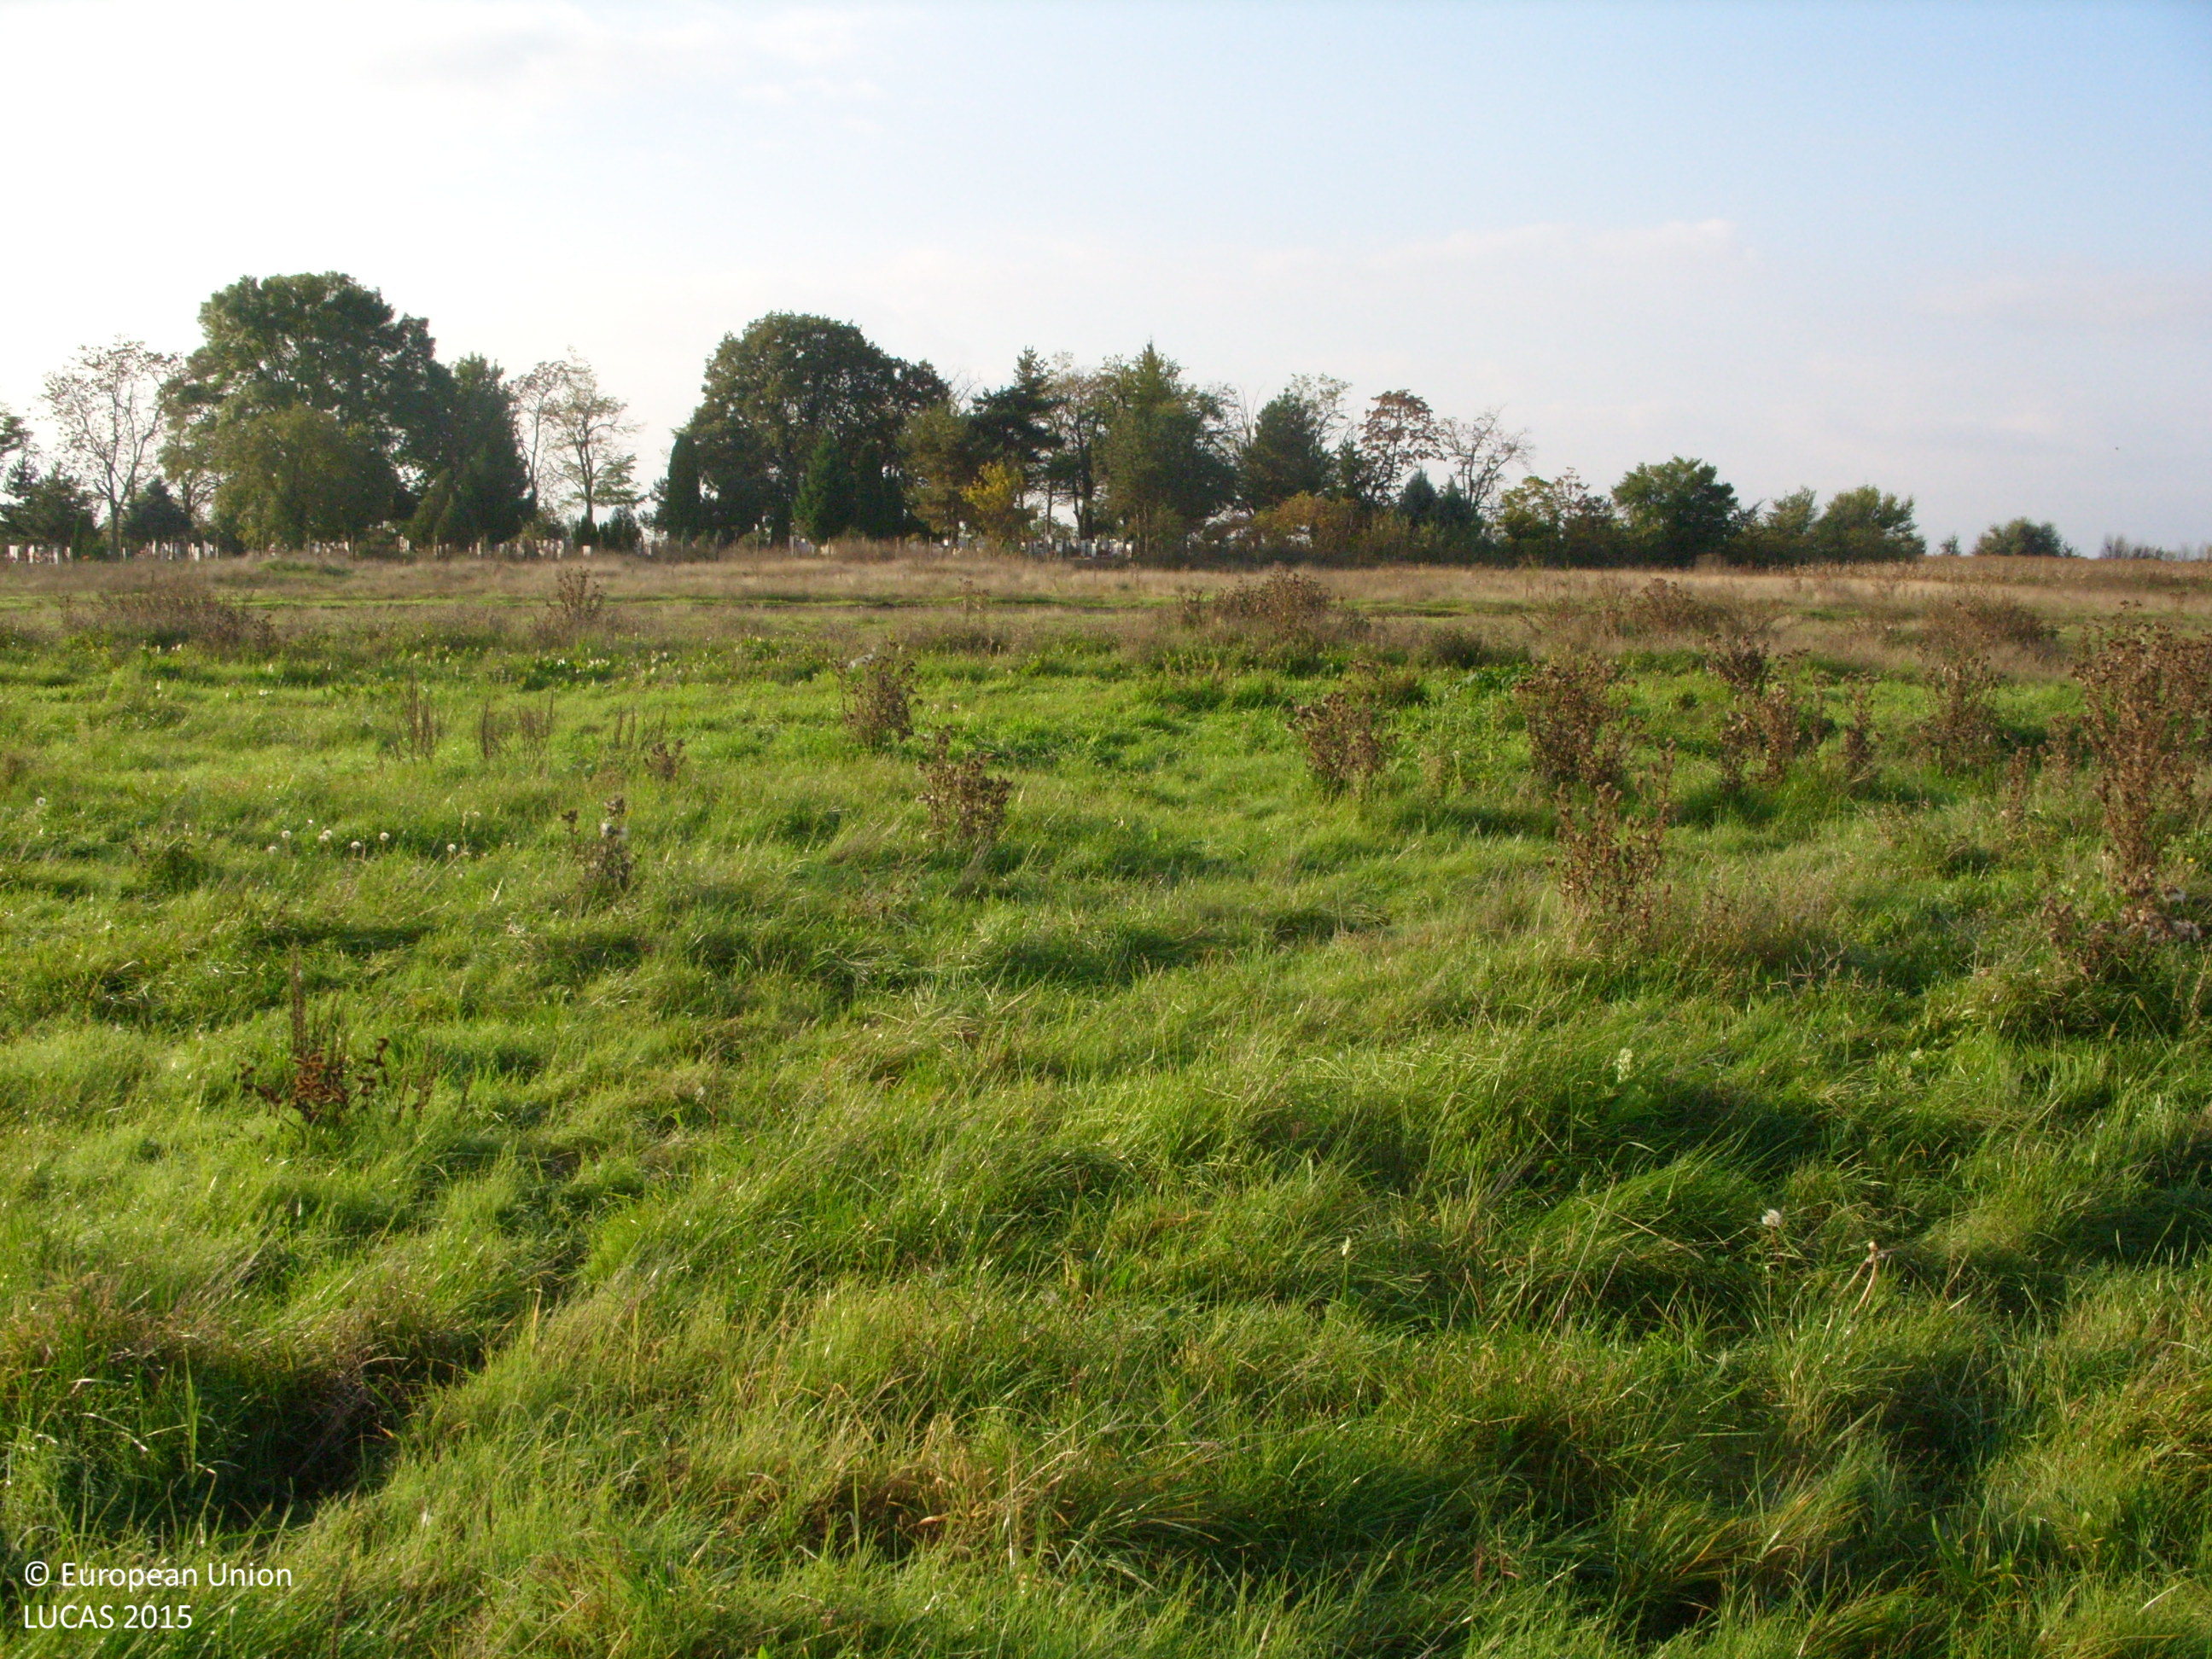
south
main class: Grassland
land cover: Grassland without tree/shrub cover
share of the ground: > 75 %
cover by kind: herbaceous plants 100 %
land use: Agriculture (excluding fallow land and kitchen gardens)
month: October
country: BG
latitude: 42.3827
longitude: 24.6888
